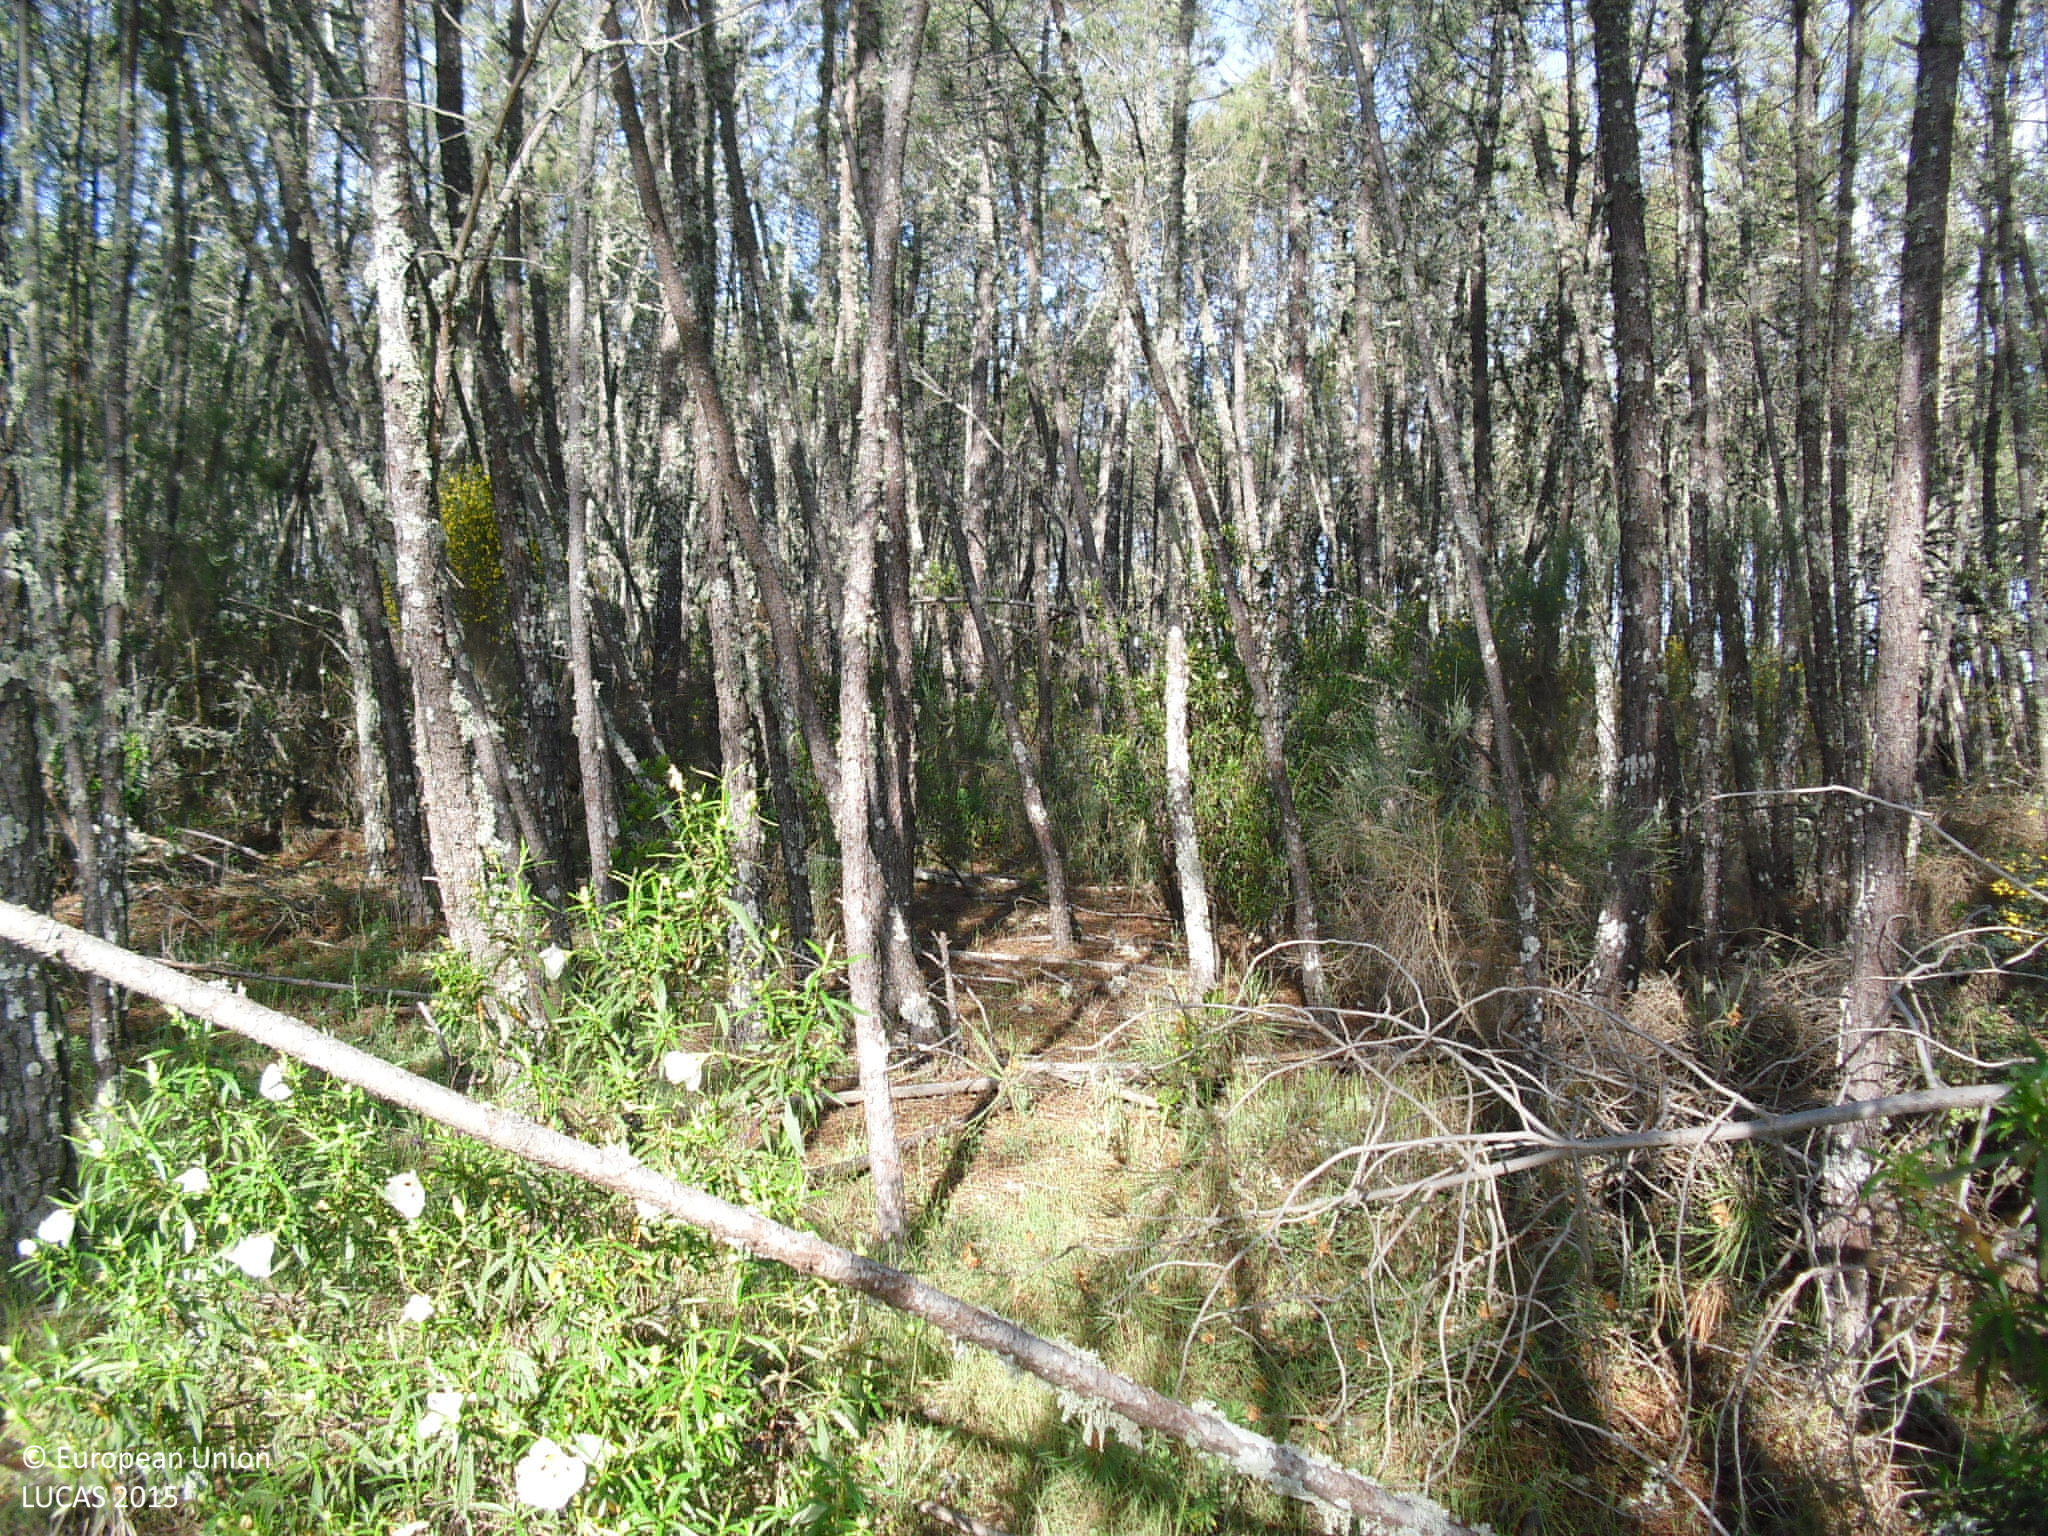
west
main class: Woodland
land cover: Pine dominated coniferous woodland
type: coniferous forest of the mediterranean region
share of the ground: > 75 %
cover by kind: coniferous forest trees 90 %, herbaceous plants 10 %
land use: Forestry
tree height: > 5 m
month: April
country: ES
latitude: 40.0574
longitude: -6.8161
